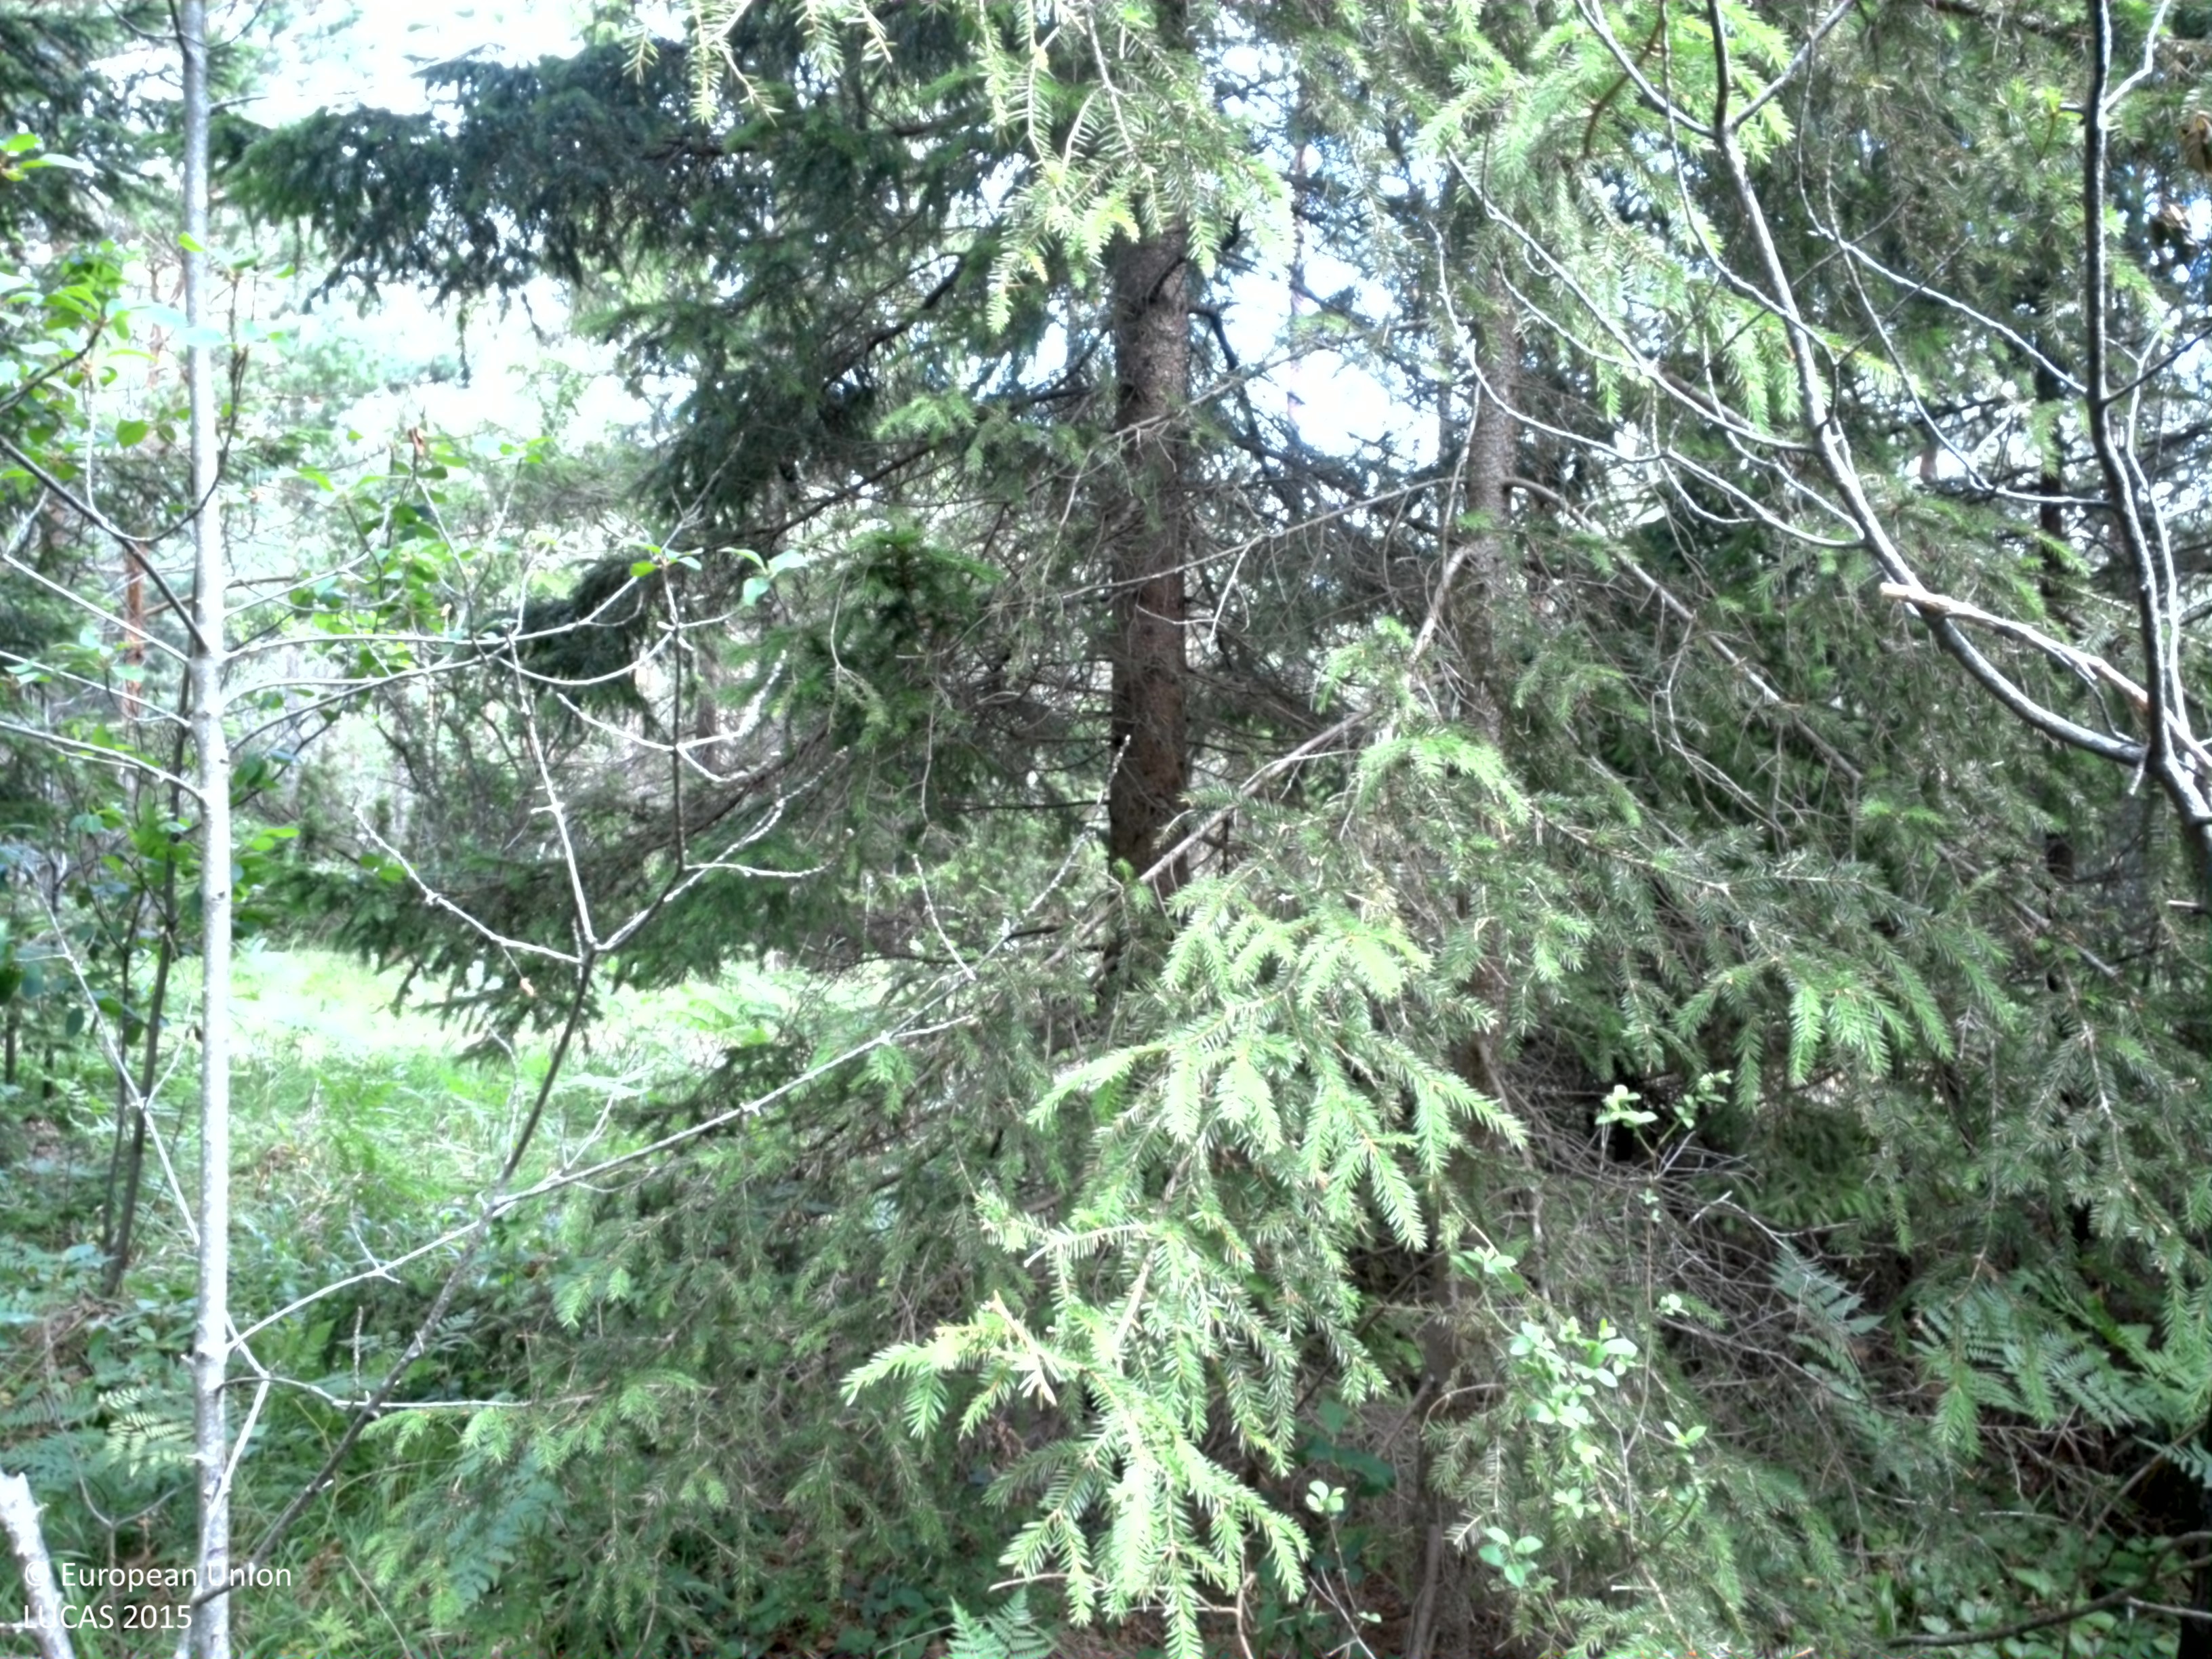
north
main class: Woodland
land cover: Pine dominated coniferous woodland
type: hemiboreal forest and nemoral coniferous forest and mixed broadleaved-coniferous forest
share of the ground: > 75 %
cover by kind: coniferous forest trees 75 %, herbaceous plants 15 %, shrubs 5 %, unconsolidated bare surface 5 %
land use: Forestry
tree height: > 5 m
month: July
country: SE
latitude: 57.5536
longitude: 18.7504
